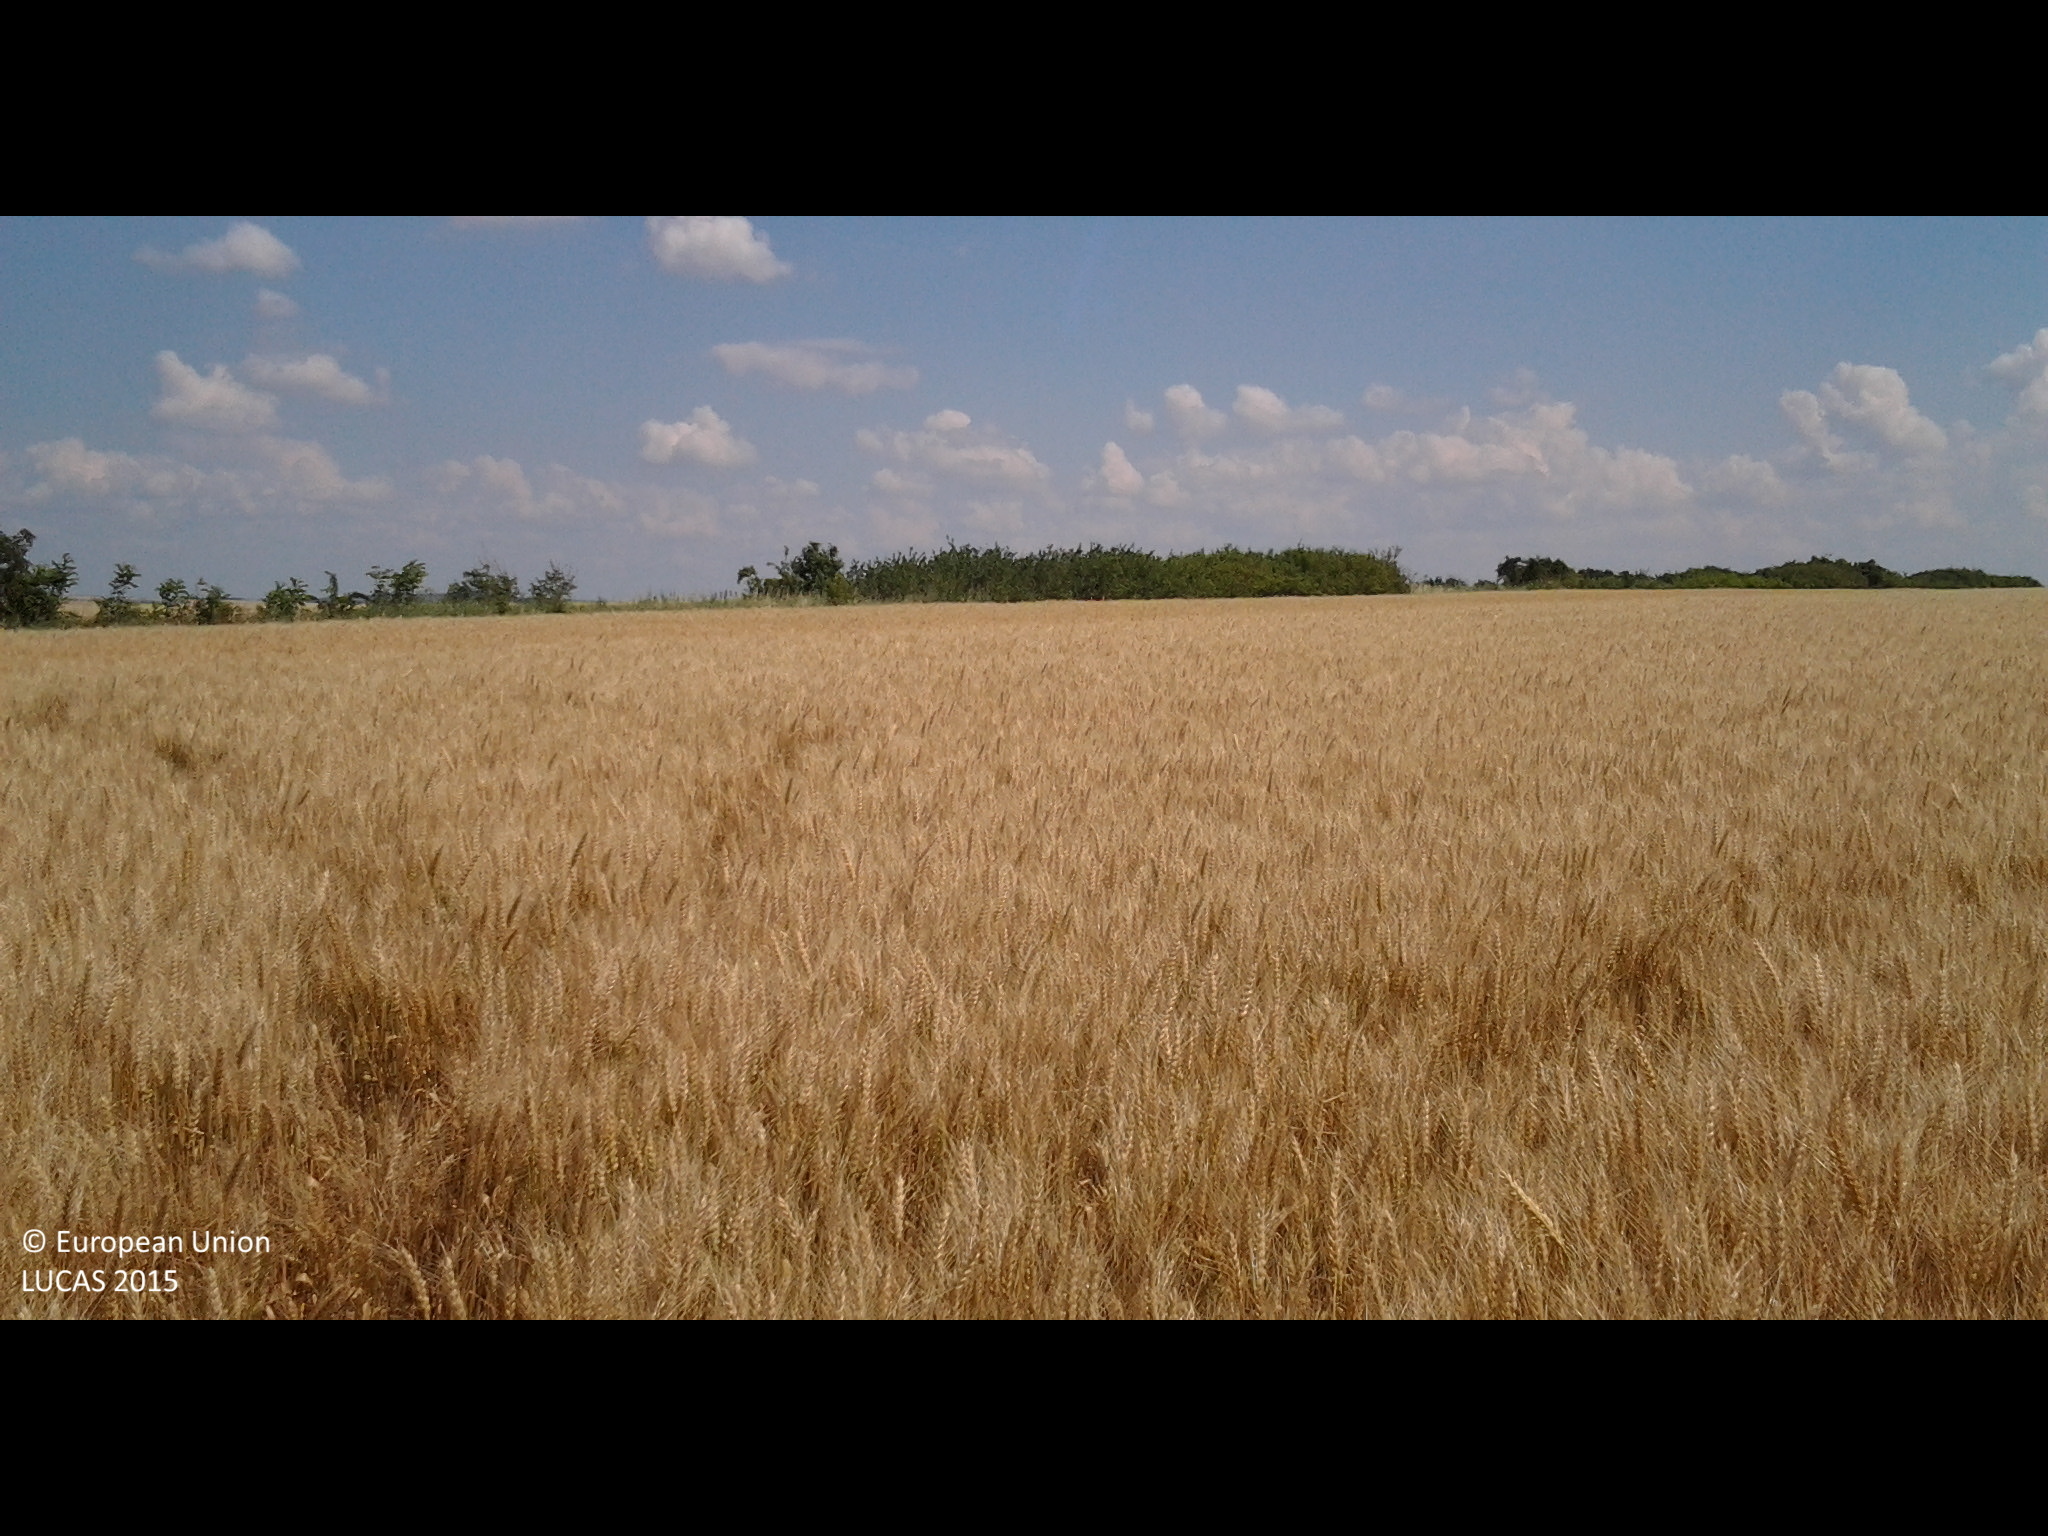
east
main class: Cropland
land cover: Common wheat
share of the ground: > 75 %
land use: Agriculture (excluding fallow land and kitchen gardens)
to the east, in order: Common wheat; Lines of trees; Grass margins; Tracks; Spontaneously vegetated surfaces; Common wheat
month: June
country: RO
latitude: 47.5582
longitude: 27.0770
